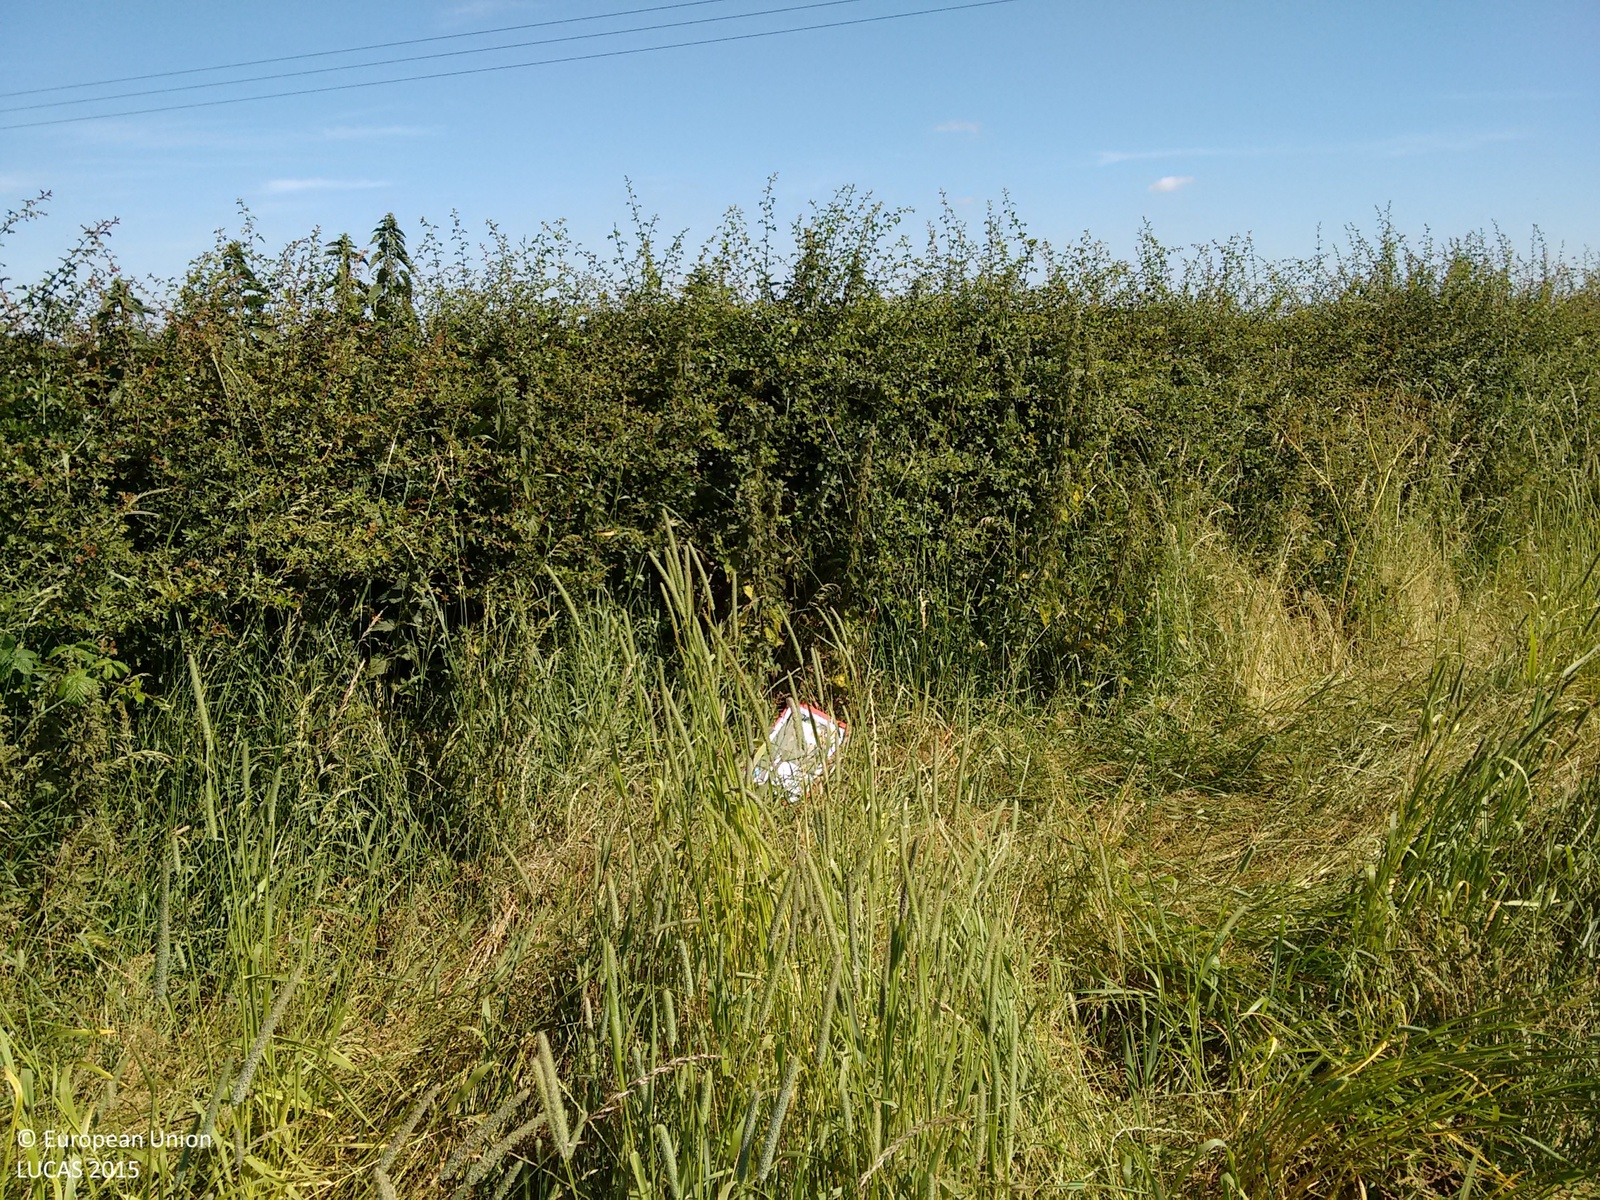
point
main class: Cropland
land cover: Common wheat
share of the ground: > 75 %
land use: Agriculture (excluding fallow land and kitchen gardens)
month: July
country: GB
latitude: 52.8975
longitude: -0.8191
